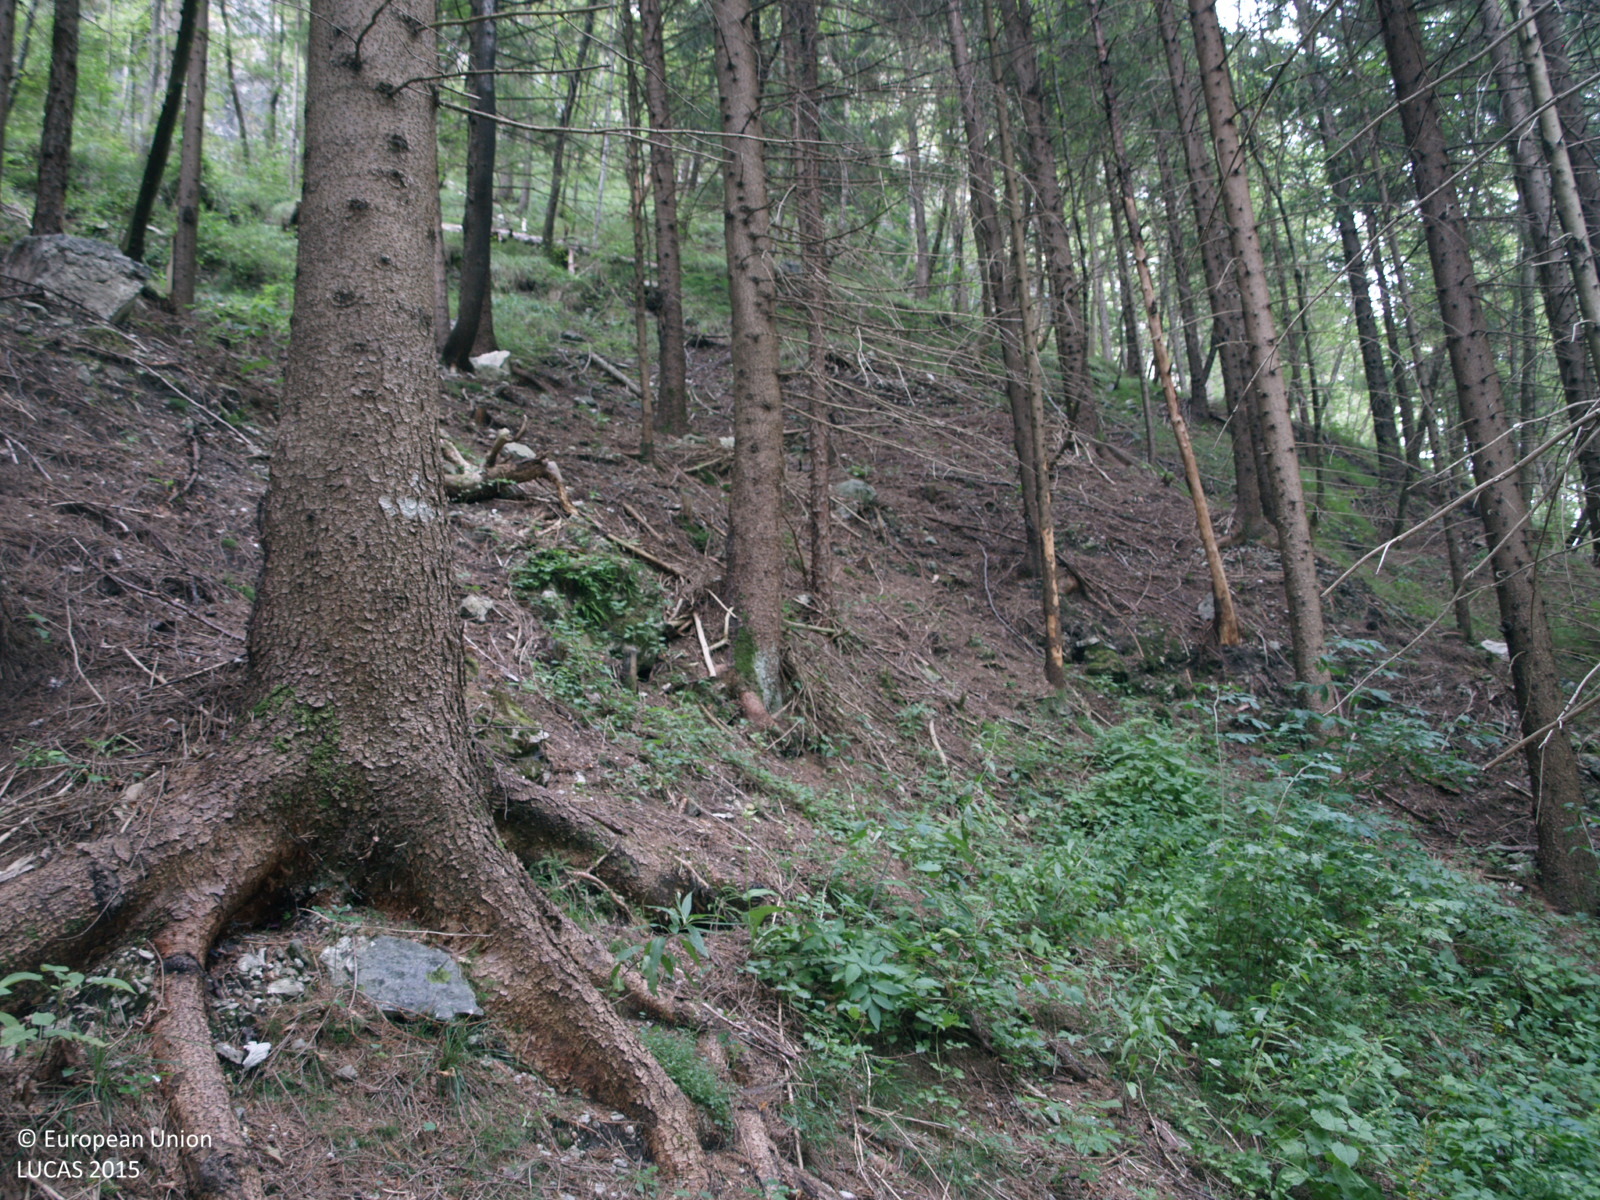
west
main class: Woodland
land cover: Spruce dominated coniferous woodland
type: alpine coniferous forest
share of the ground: > 75 %
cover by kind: coniferous forest trees 90 %, broadleaved forest trees 10 %
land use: Forestry
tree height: > 5 m
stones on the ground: > 50 %
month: May
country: IT
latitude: 46.0784
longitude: 10.7360
